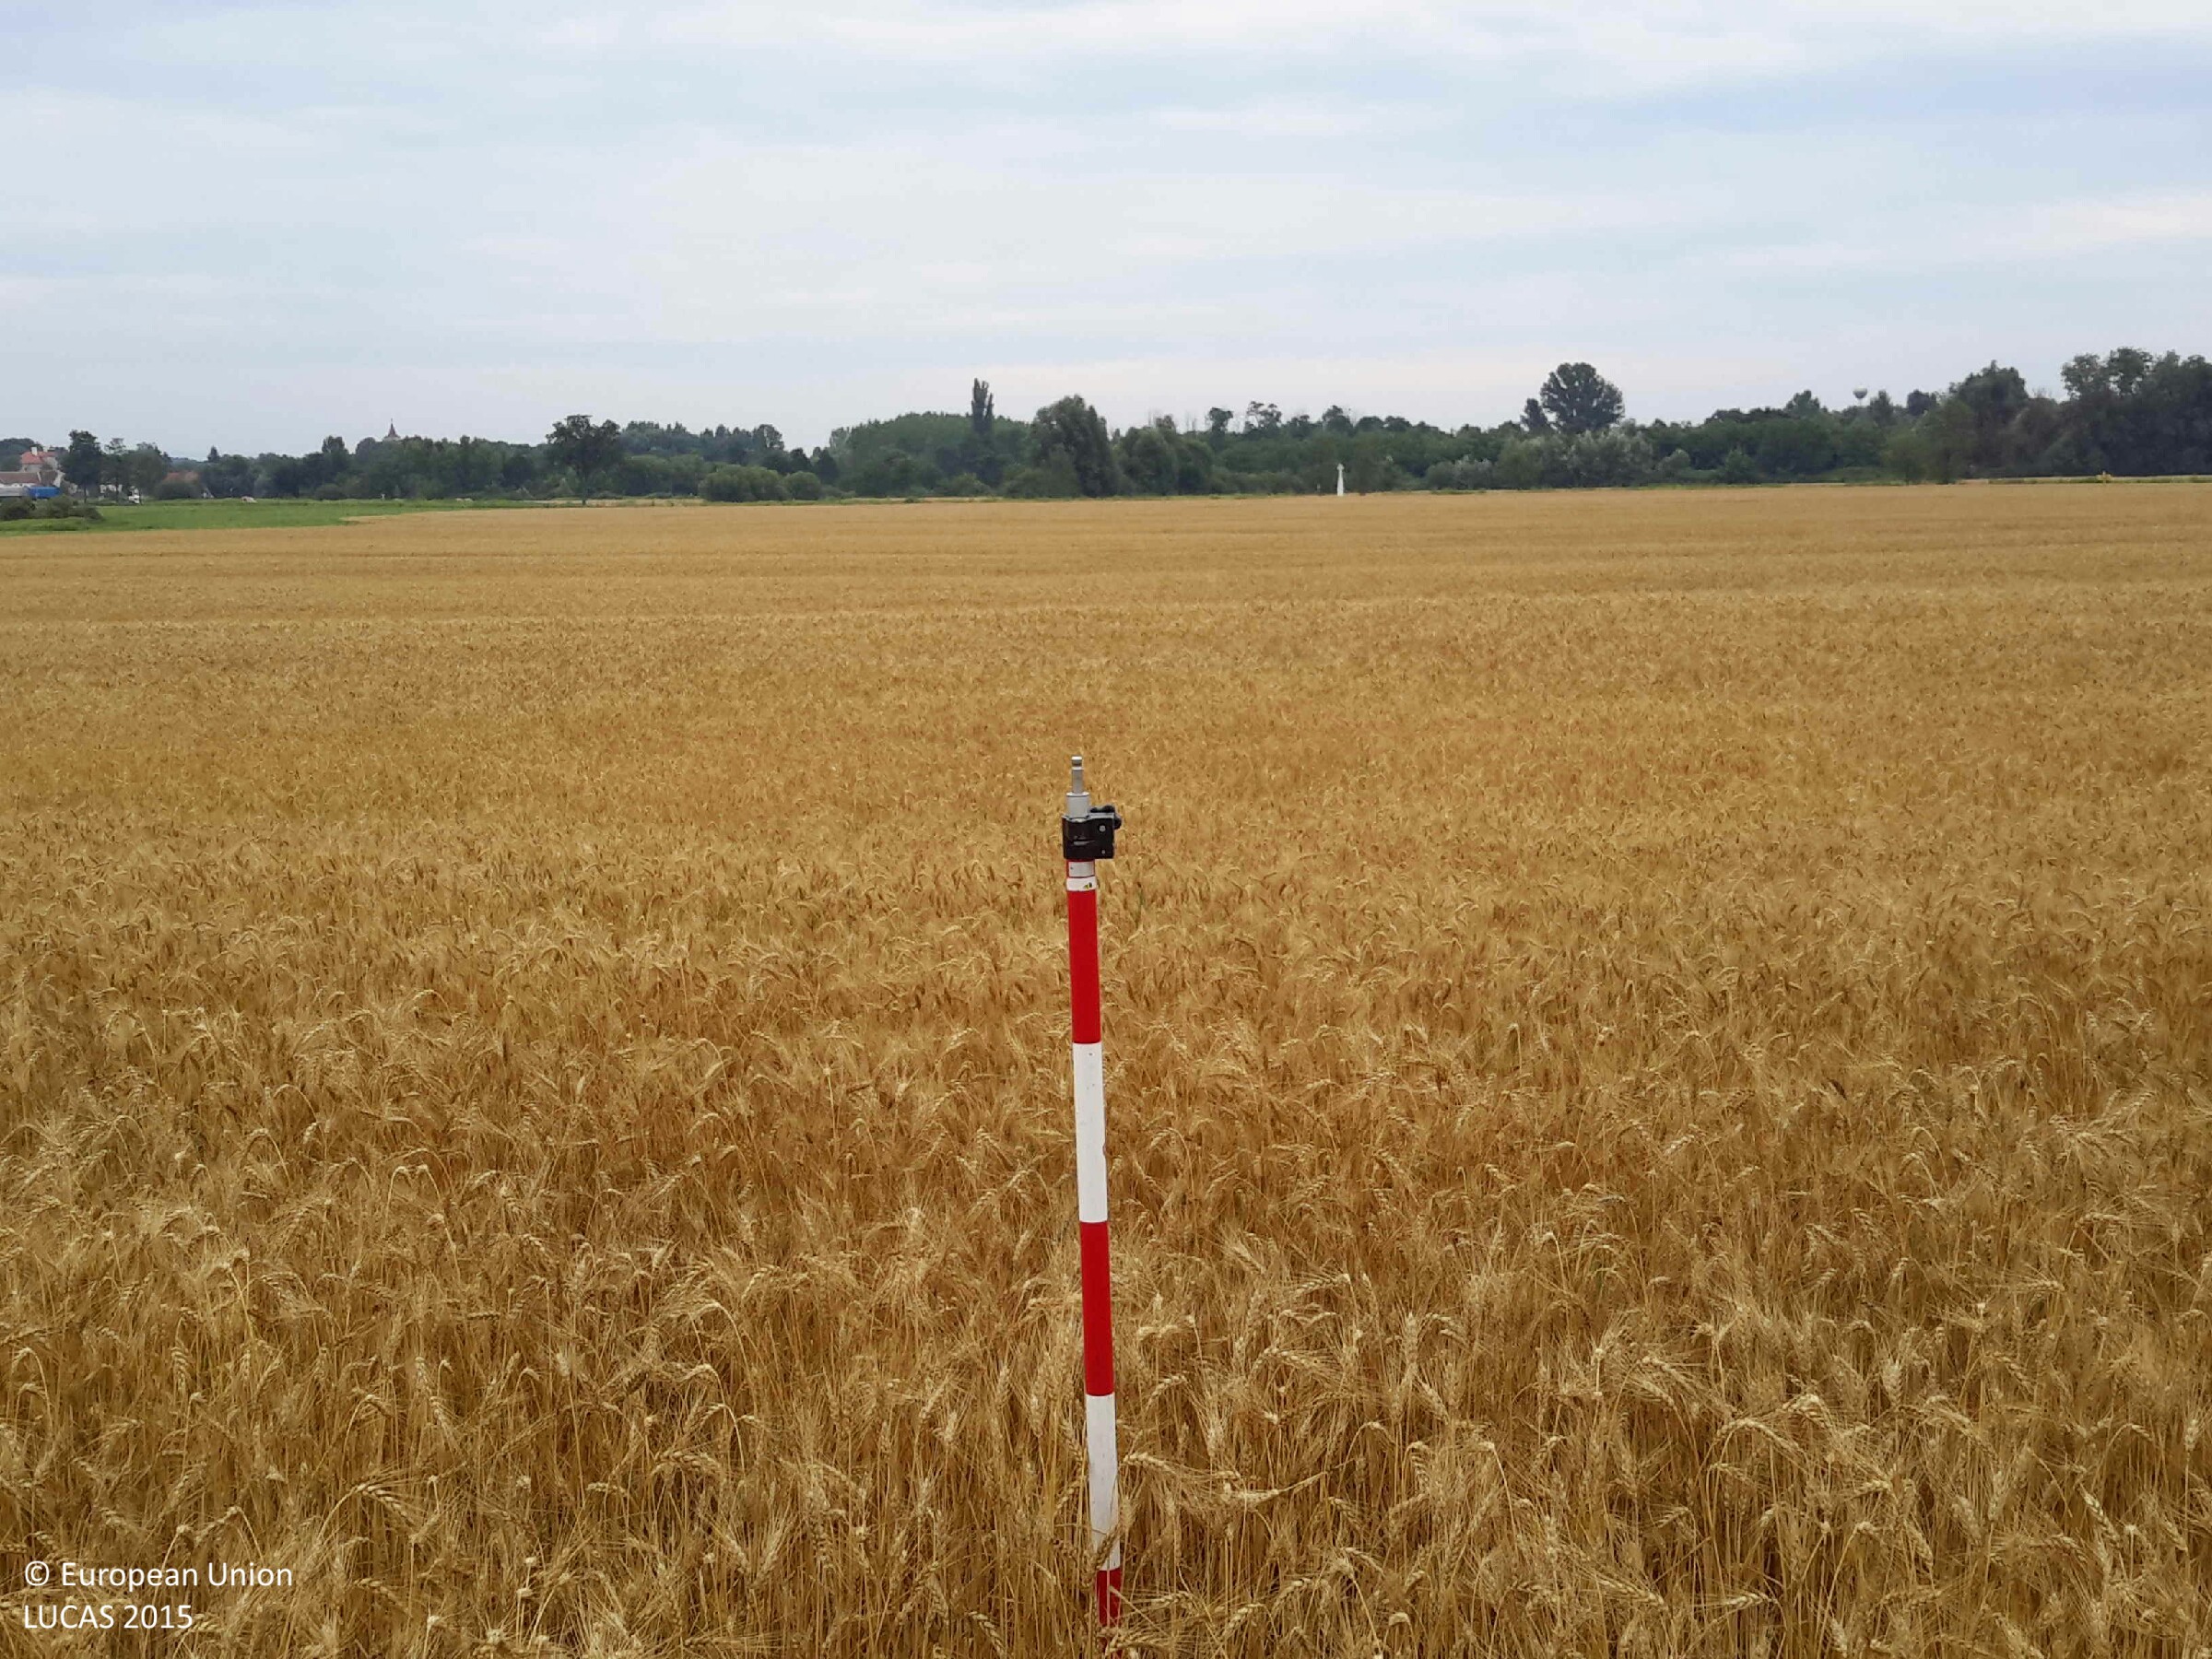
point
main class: Cropland
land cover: Common wheat
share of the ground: > 75 %
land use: Agriculture (excluding fallow land and kitchen gardens)
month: July
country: HU
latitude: 47.1214
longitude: 17.1891
